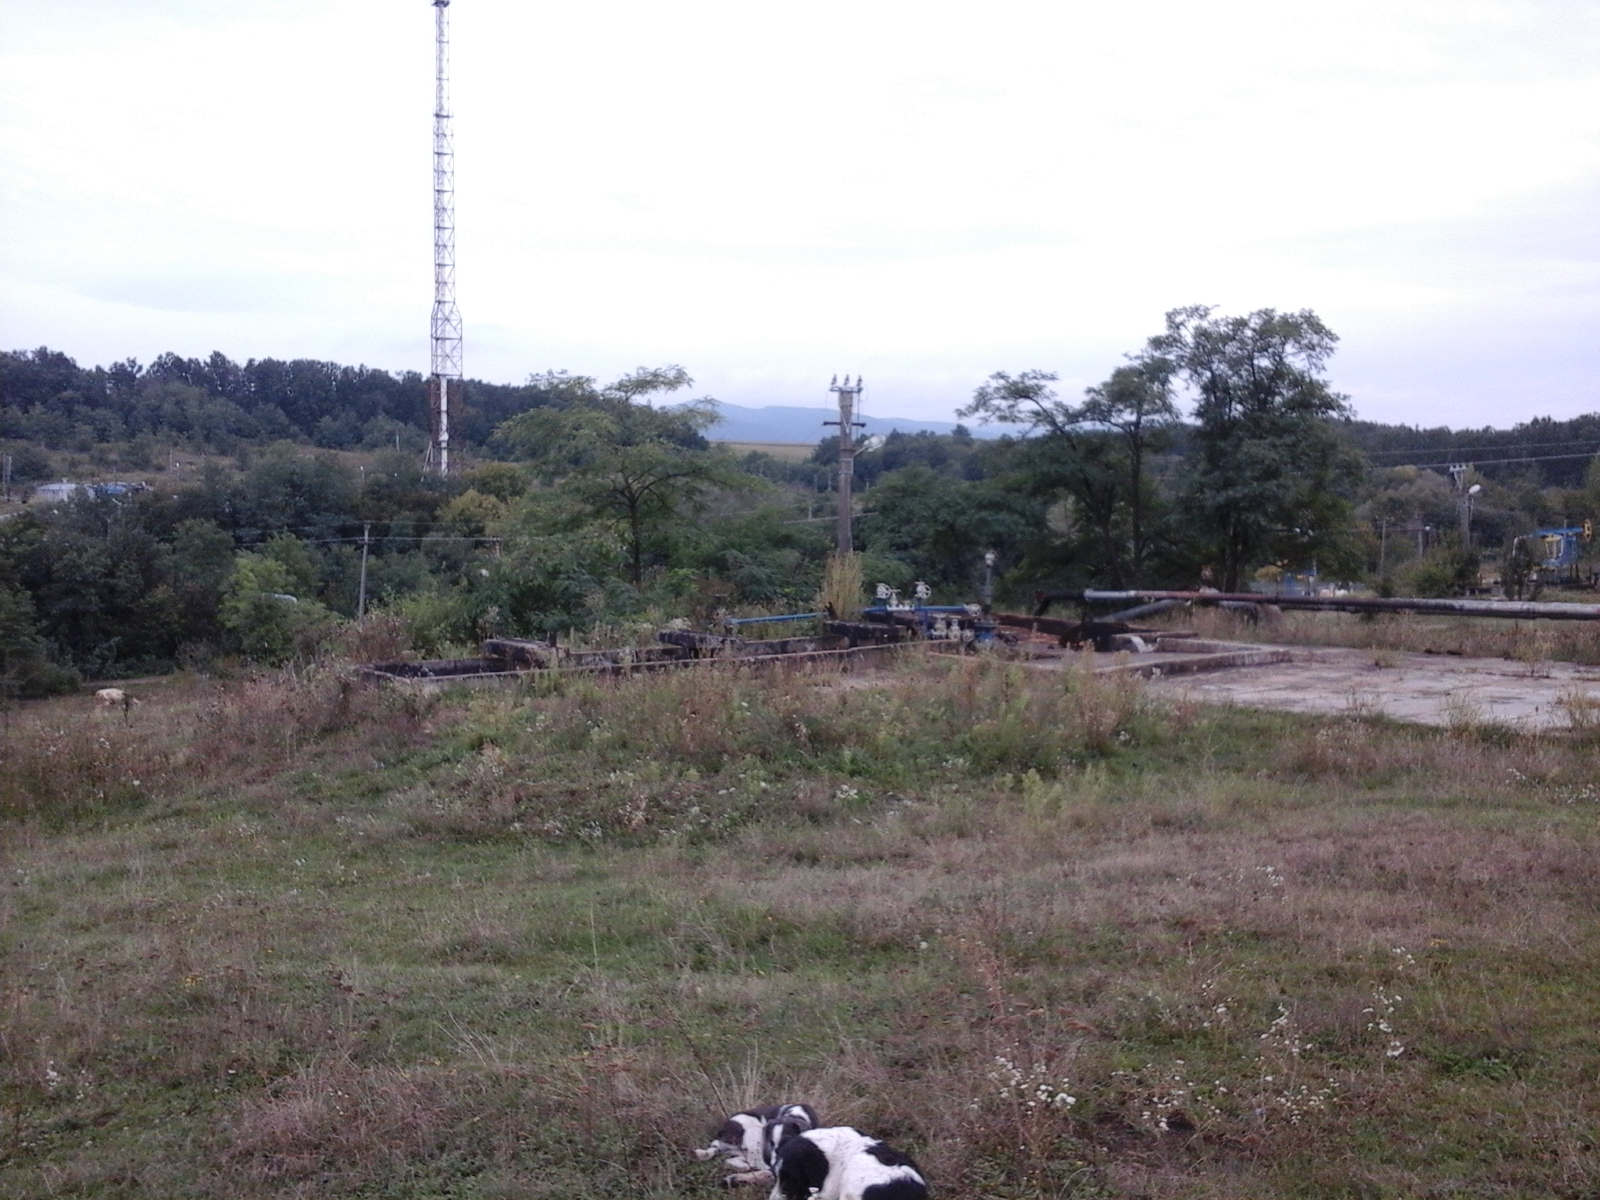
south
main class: Grassland
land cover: Grassland without tree/shrub cover
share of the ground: > 75 %
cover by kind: herbaceous plants 100 %
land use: Agriculture (excluding fallow land and kitchen gardens)
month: September
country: RO
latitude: 47.2550
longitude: 22.4899
